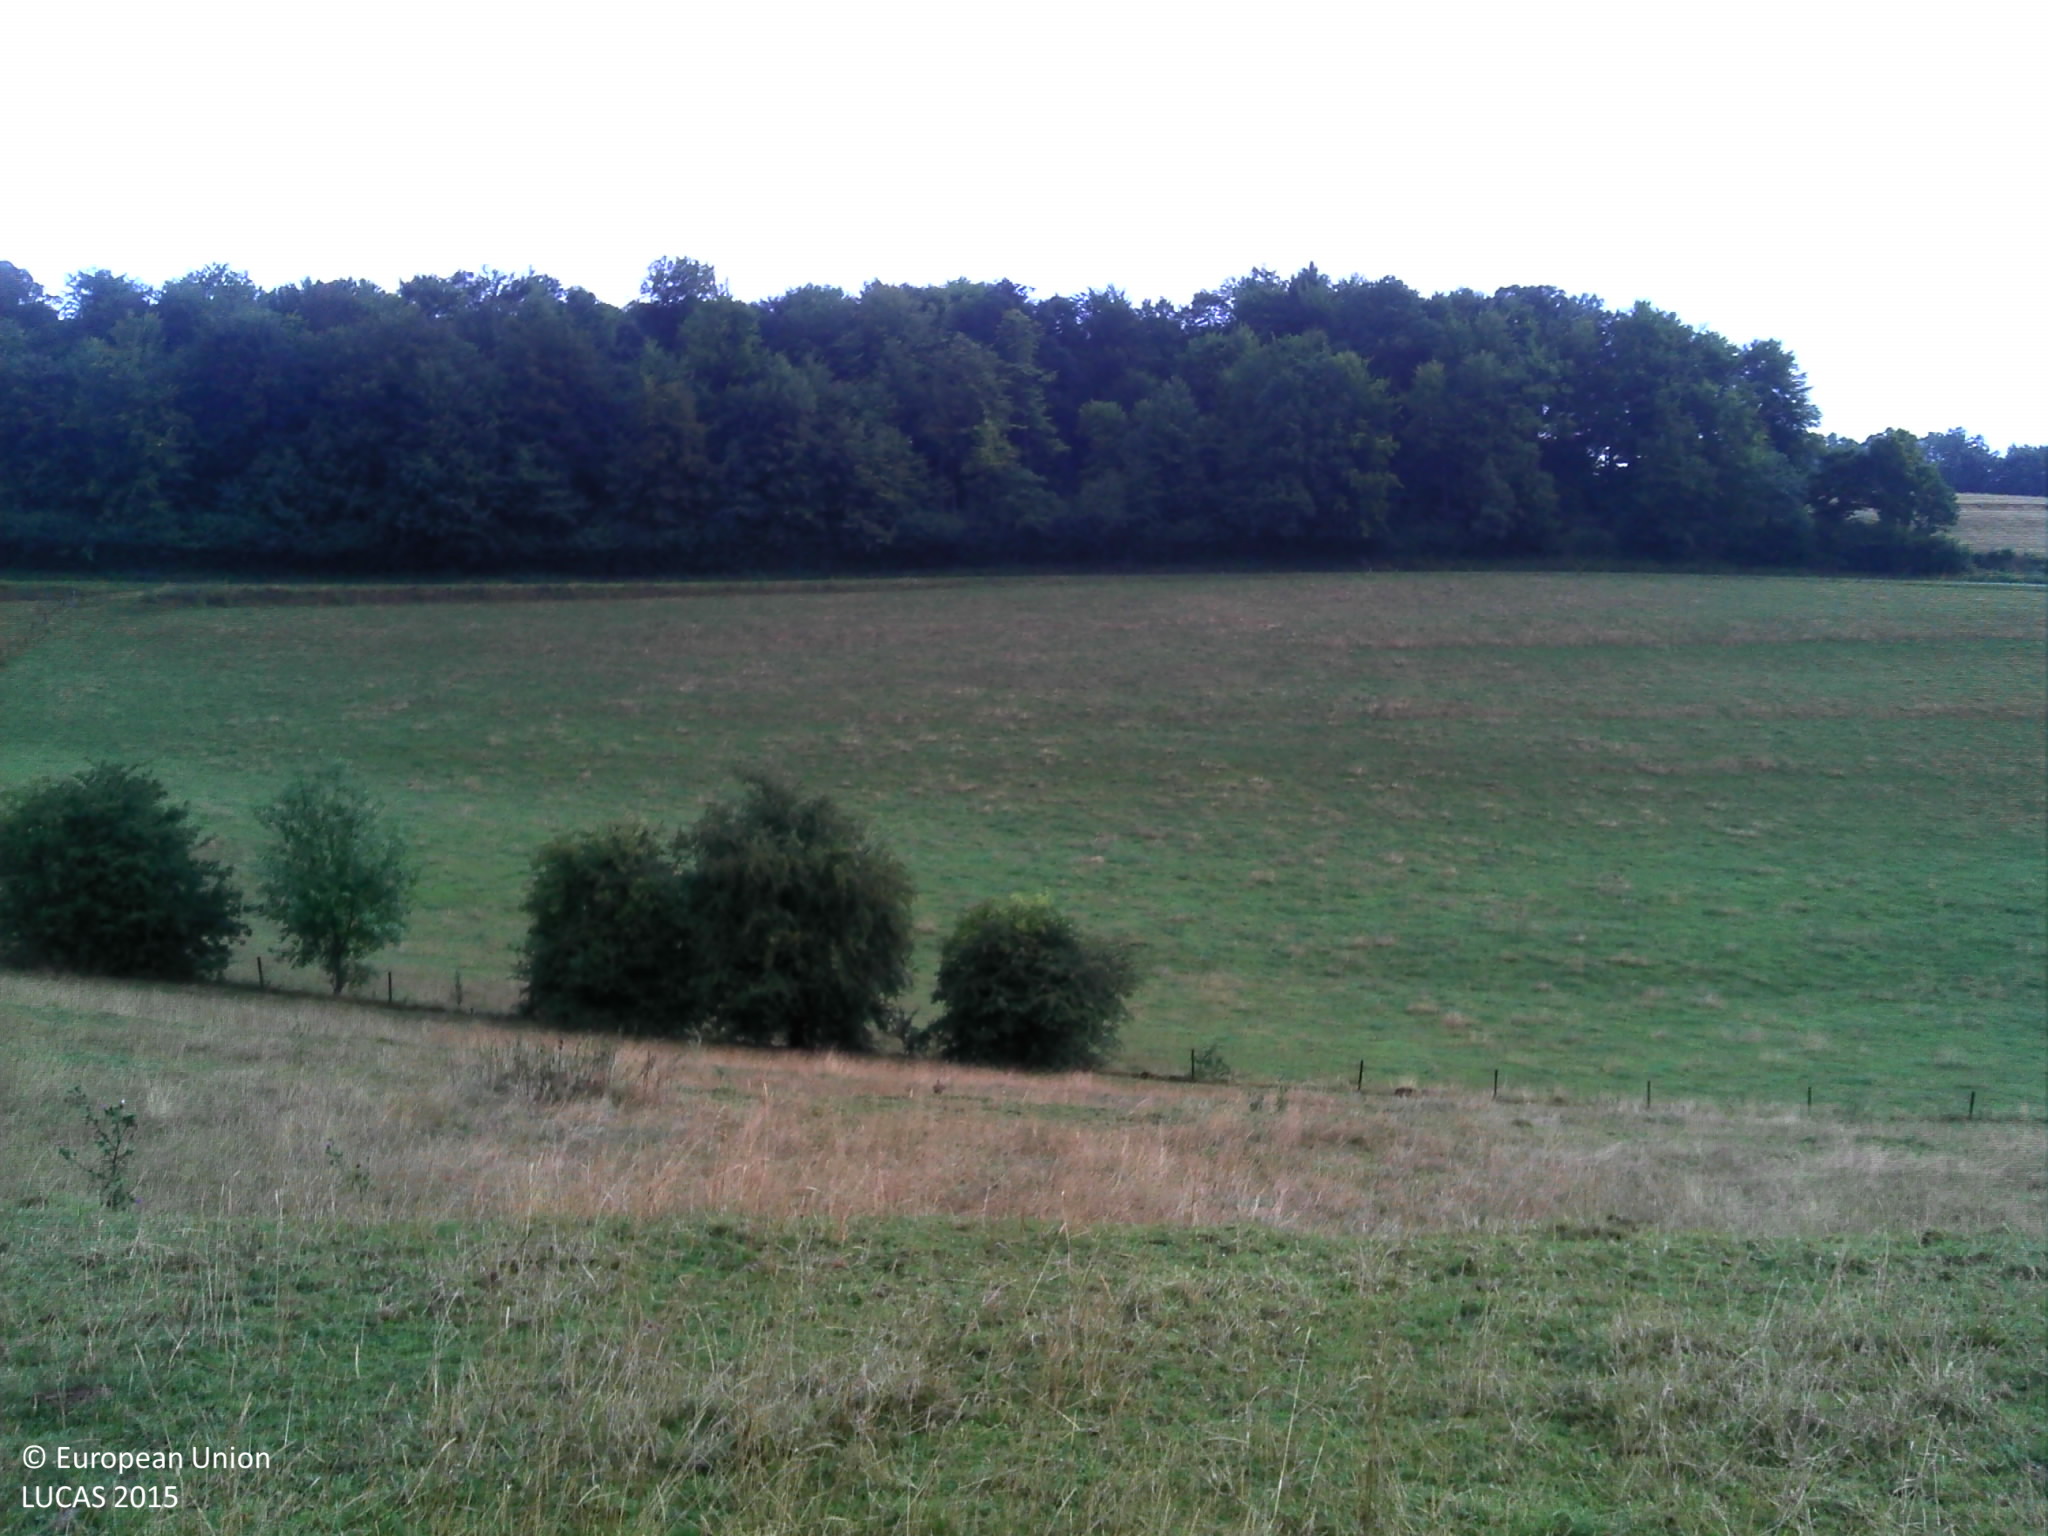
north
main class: Grassland
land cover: Grassland without tree/shrub cover
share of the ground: > 75 %
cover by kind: herbaceous plants 100 %
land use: Agriculture (excluding fallow land and kitchen gardens)
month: July
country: BE
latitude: 49.6019
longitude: 5.7787
